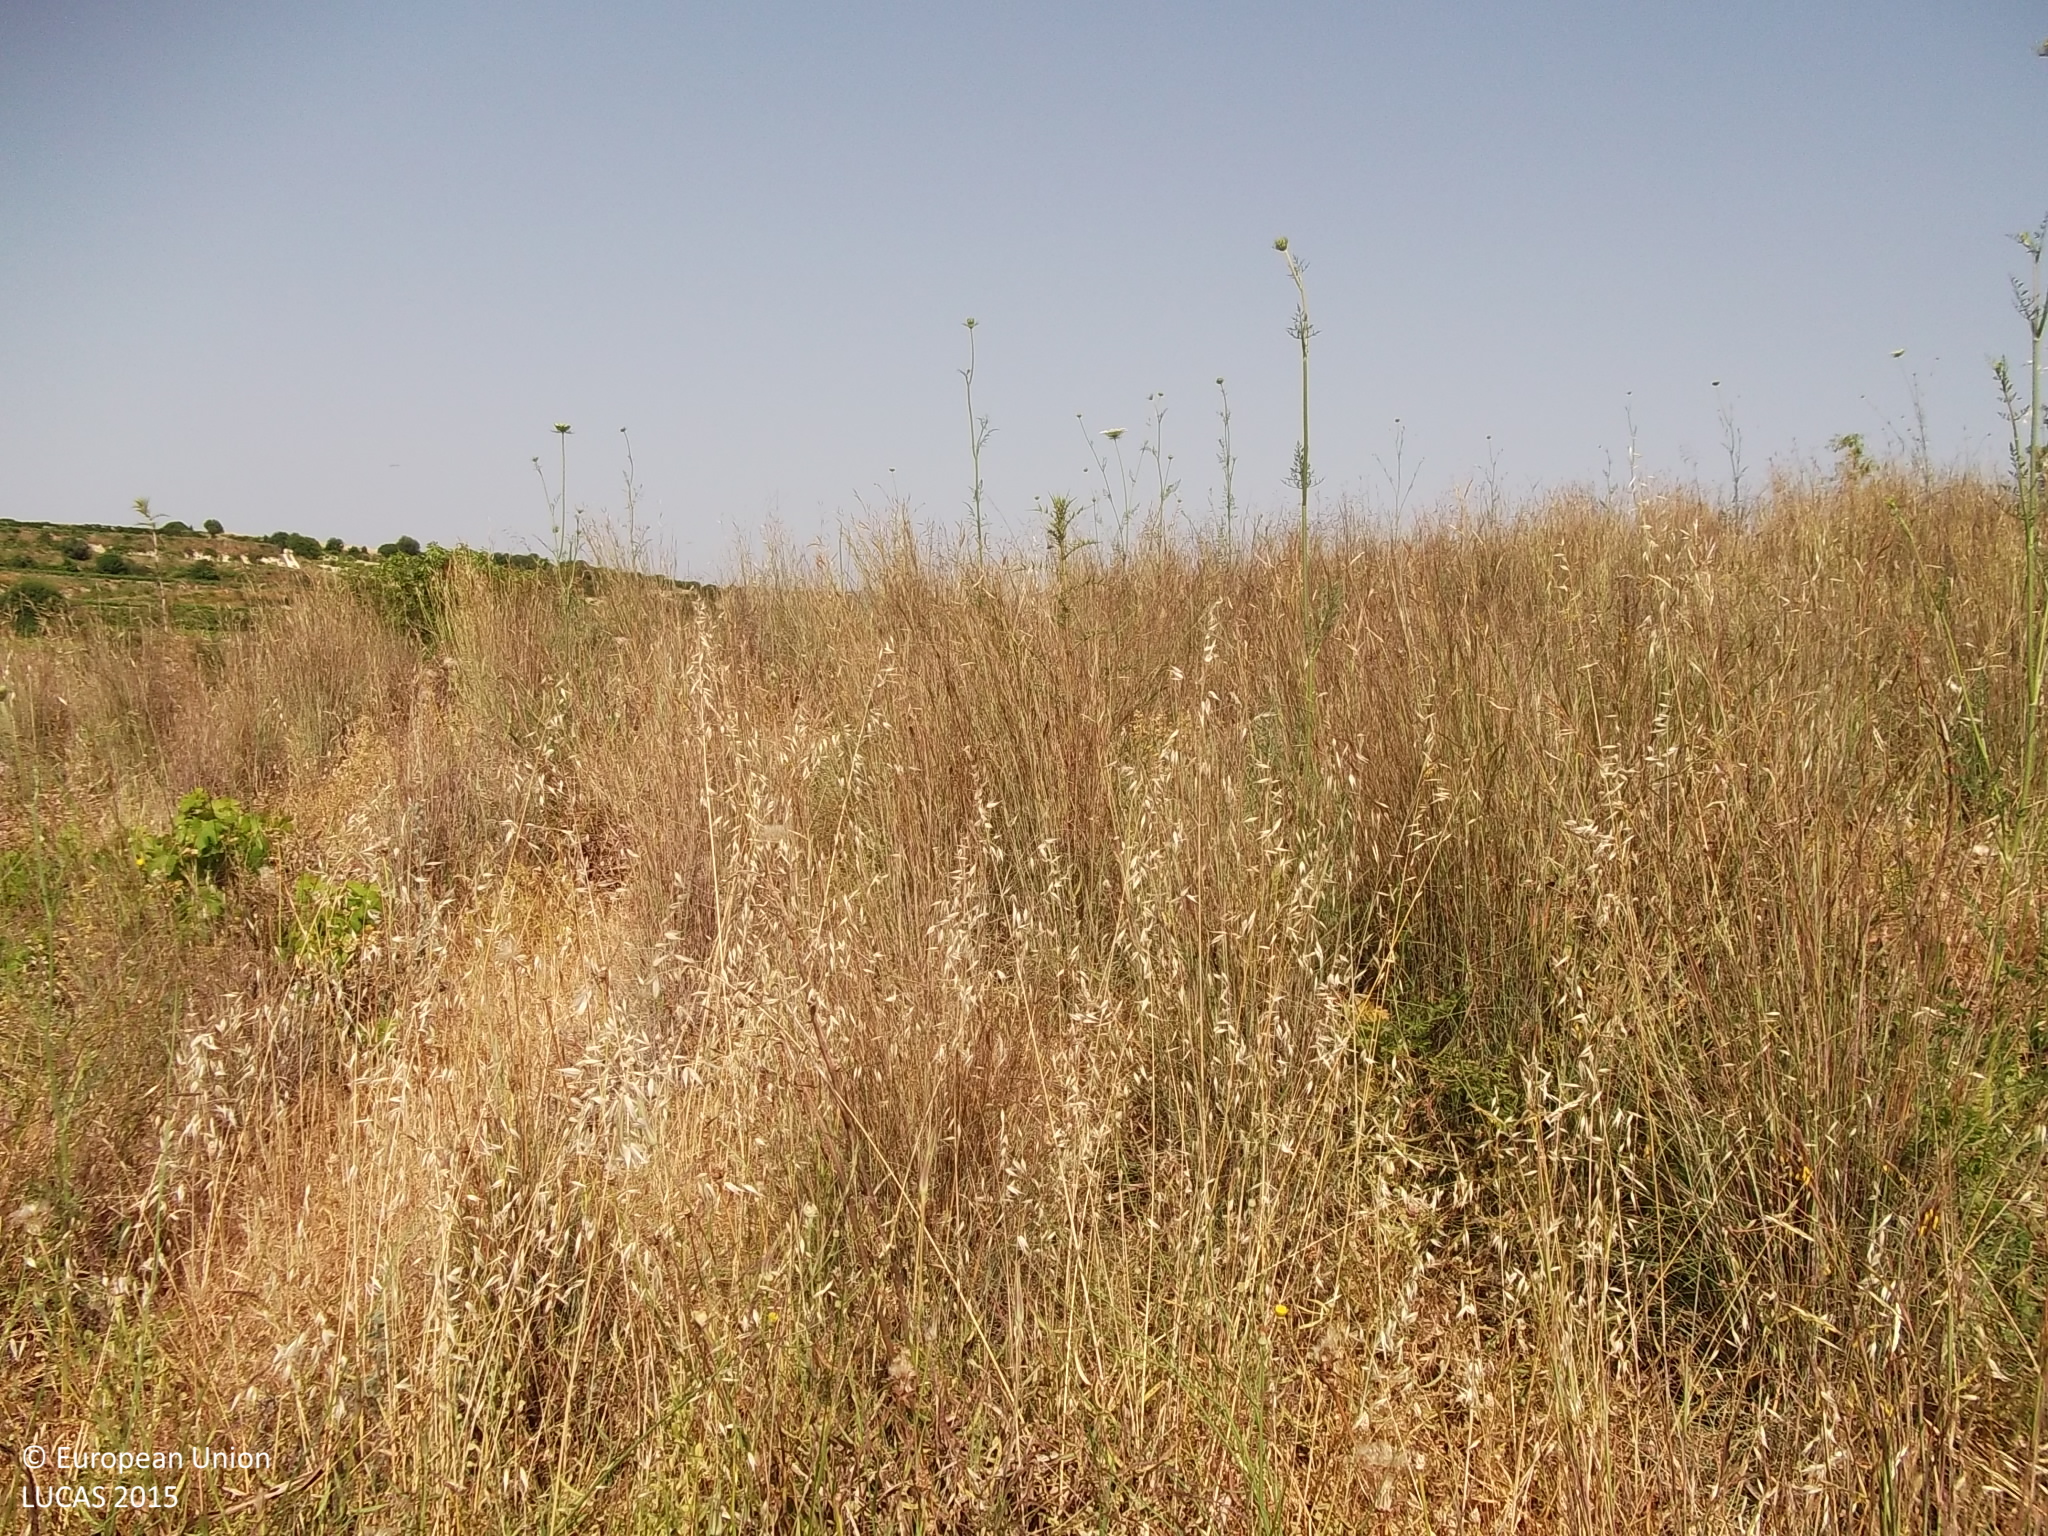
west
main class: Grassland
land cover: Grassland with sparse tree/shrub cover
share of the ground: > 75 %
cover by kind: herbaceous plants 95 %, broadleaved forest trees 5 %
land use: Semi-natural and natural areas not in use
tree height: < 5 m
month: May
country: CY
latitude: 34.8314
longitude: 32.5560
